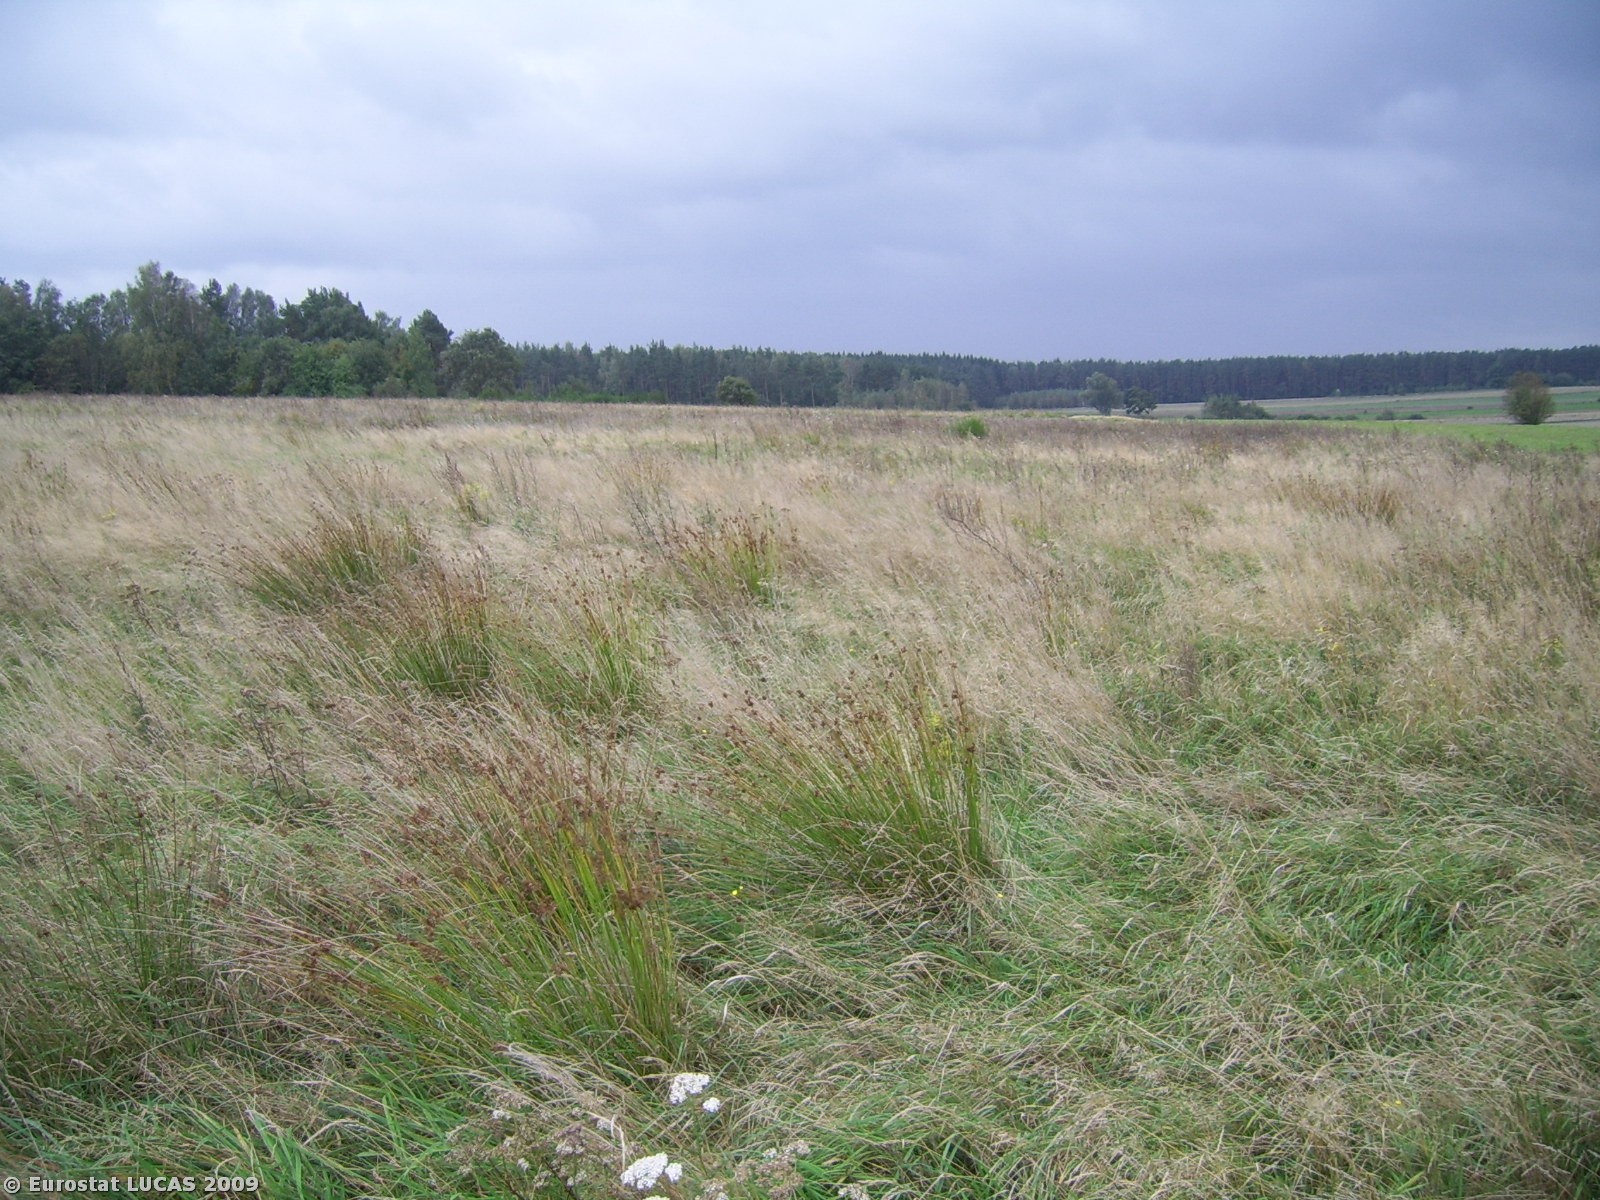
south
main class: Grassland
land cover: Grassland without tree/shrub cover
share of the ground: > 75 %
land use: Unused
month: September
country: PL
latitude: 54.2765
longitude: 16.4406
